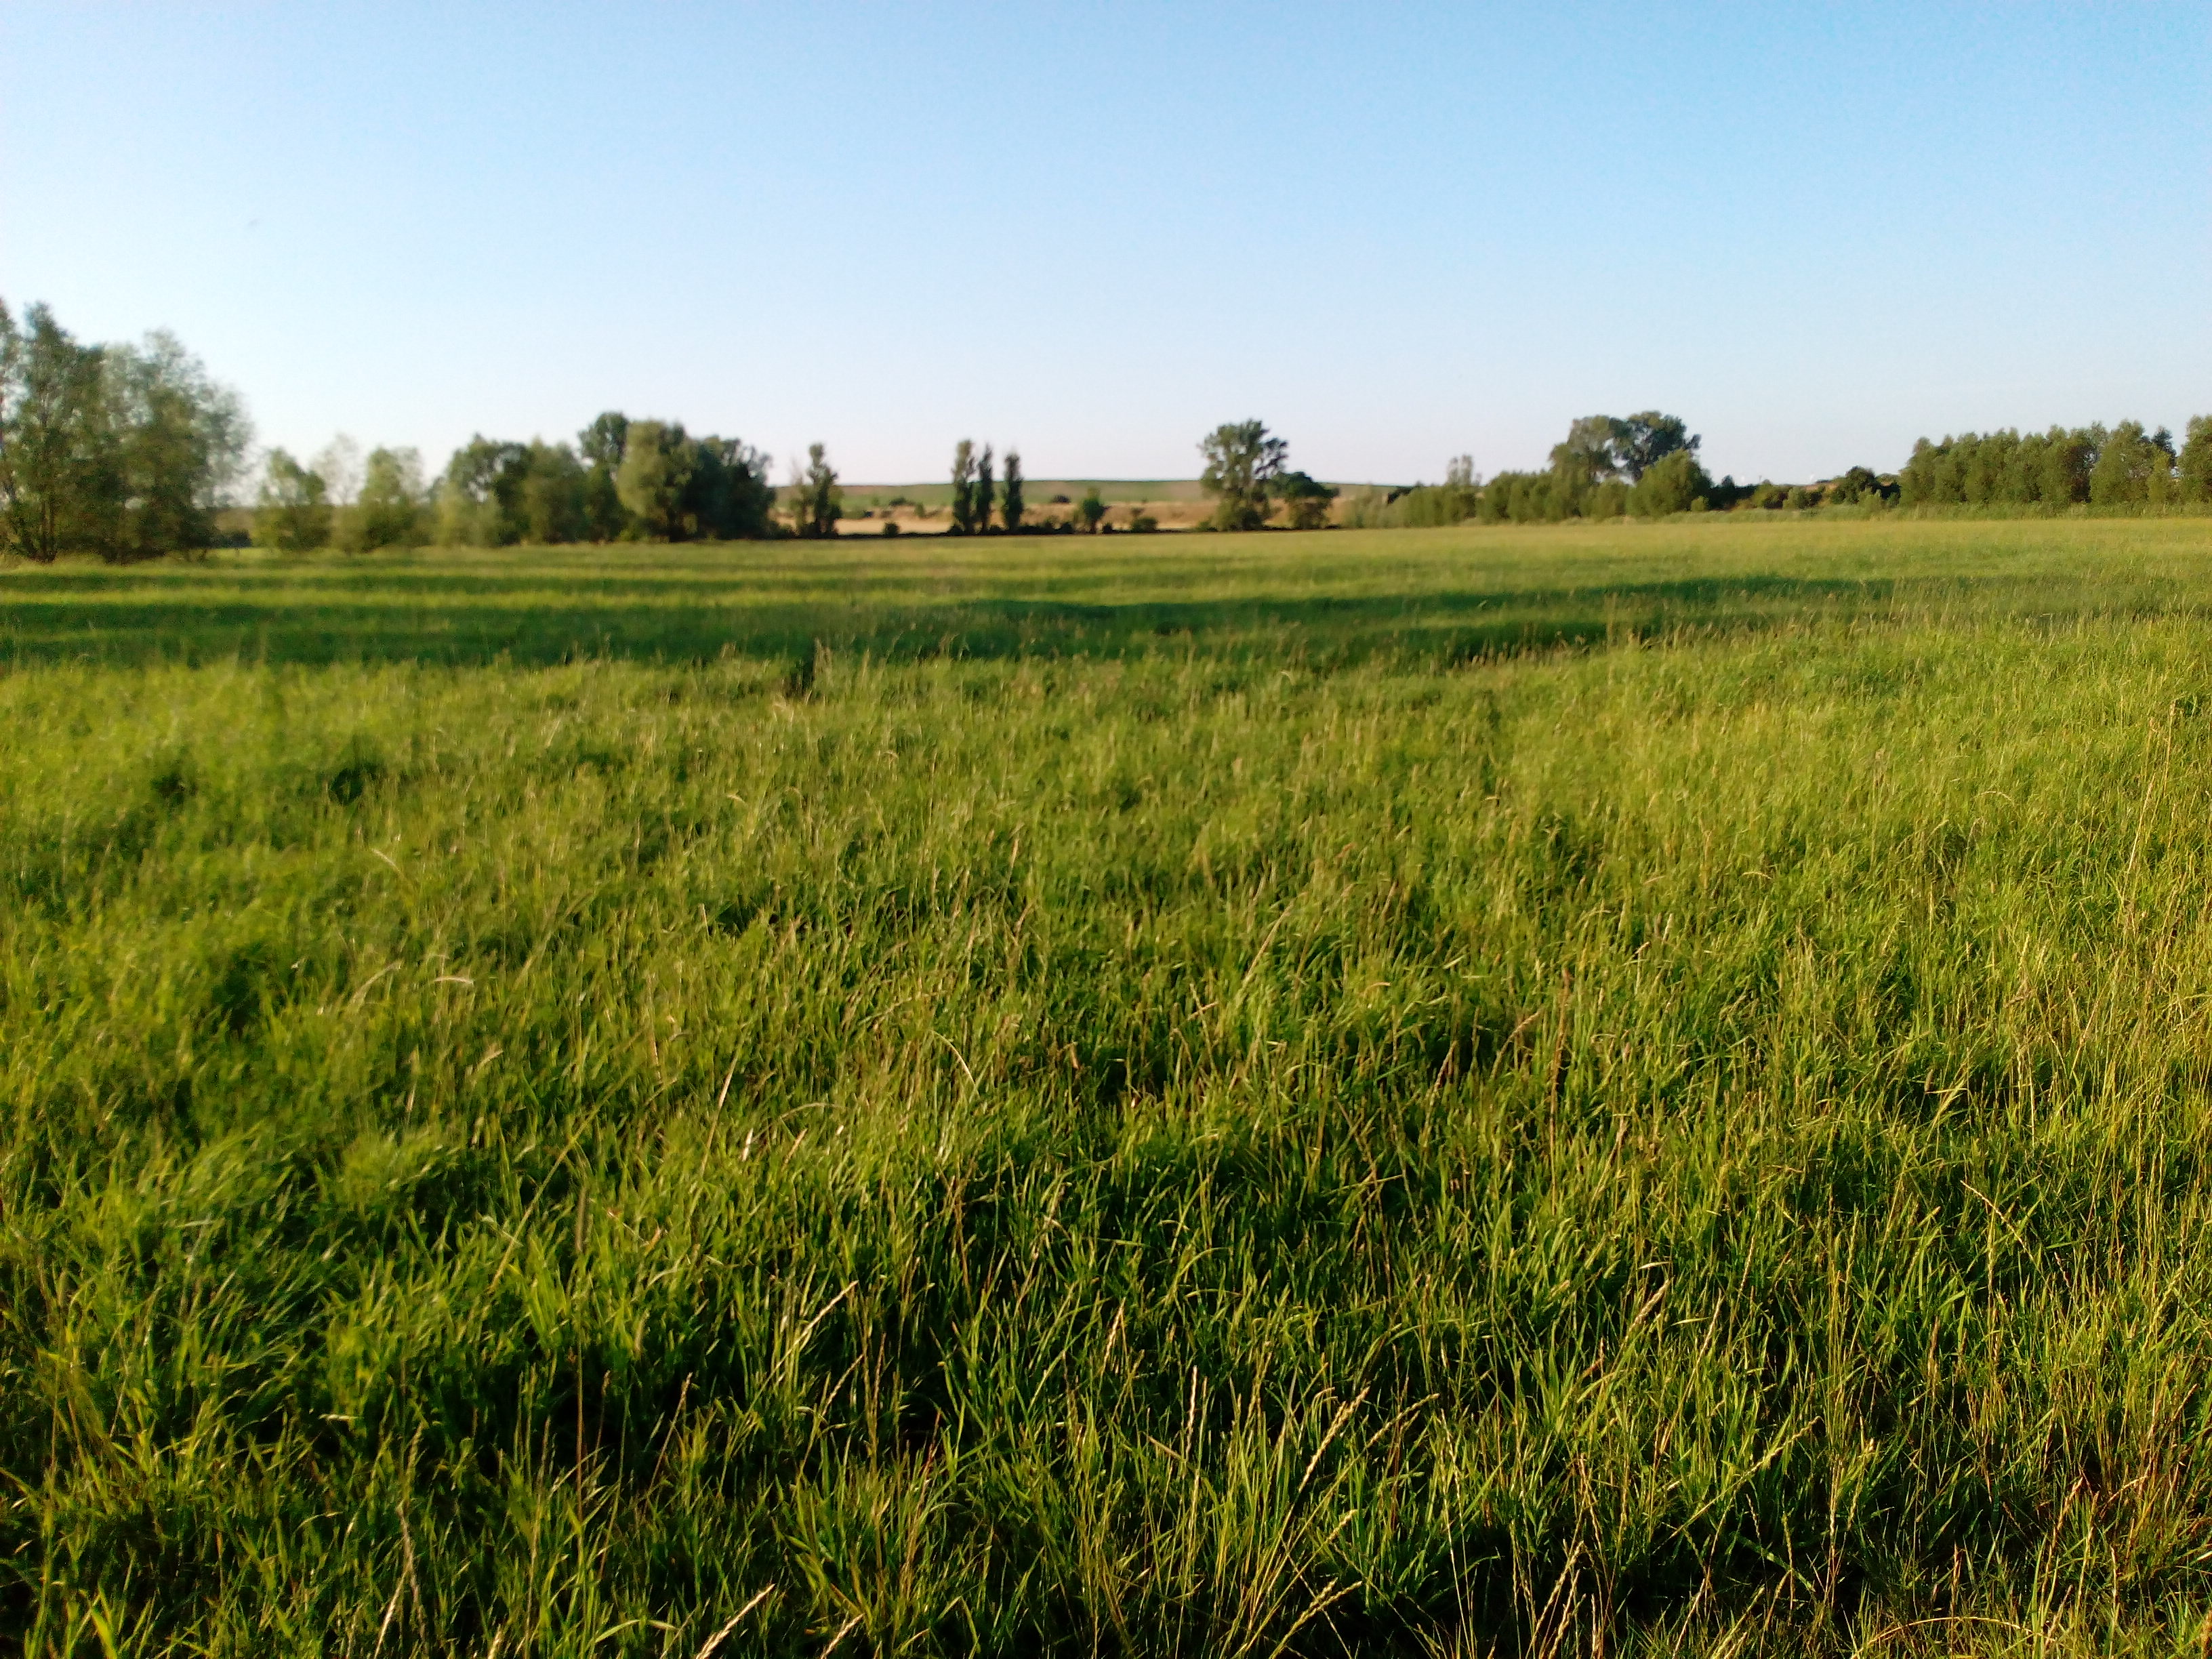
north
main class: Grassland
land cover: Grassland without tree/shrub cover
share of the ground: > 75 %
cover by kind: herbaceous plants 100 %
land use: Agriculture (excluding fallow land and kitchen gardens)
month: July
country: DE
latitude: 51.1152
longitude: 10.9568
